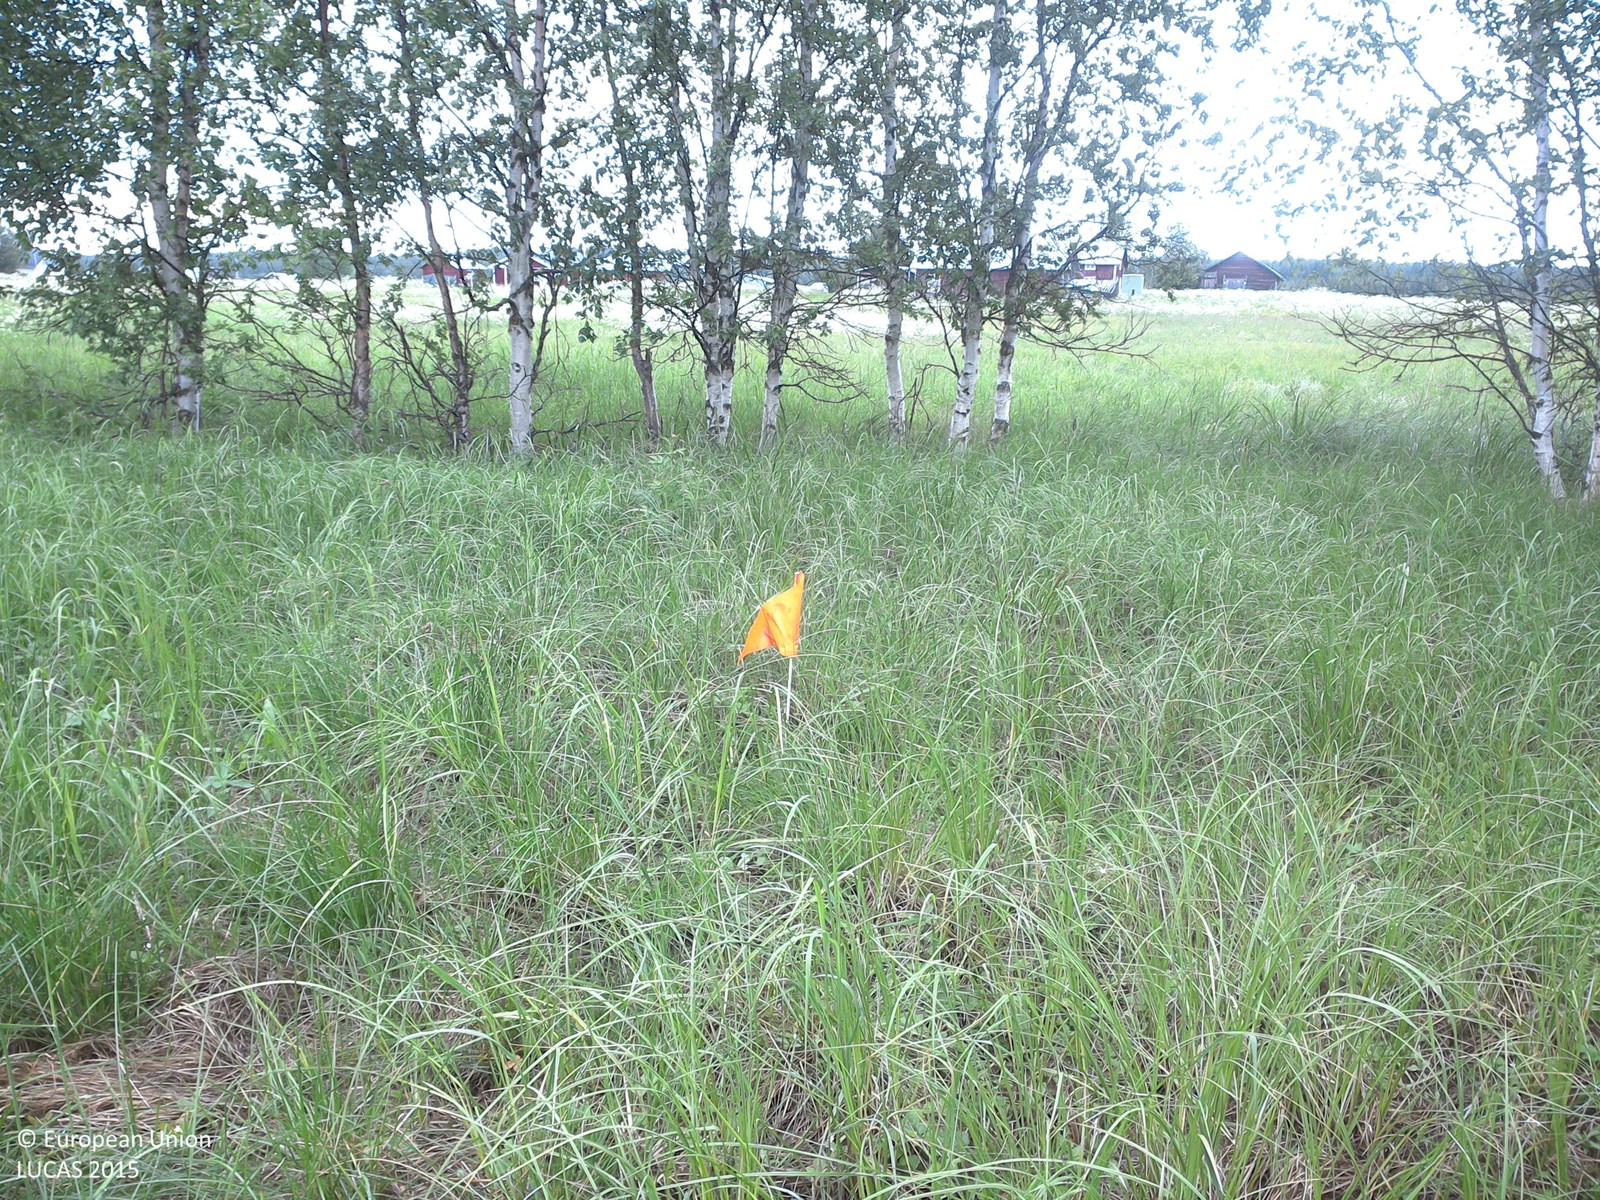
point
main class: Grassland
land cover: Grassland without tree/shrub cover
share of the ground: > 75 %
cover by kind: herbaceous plants 100 %
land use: Agriculture (excluding fallow land and kitchen gardens)
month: July
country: SE
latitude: 66.9155
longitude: 23.6707
